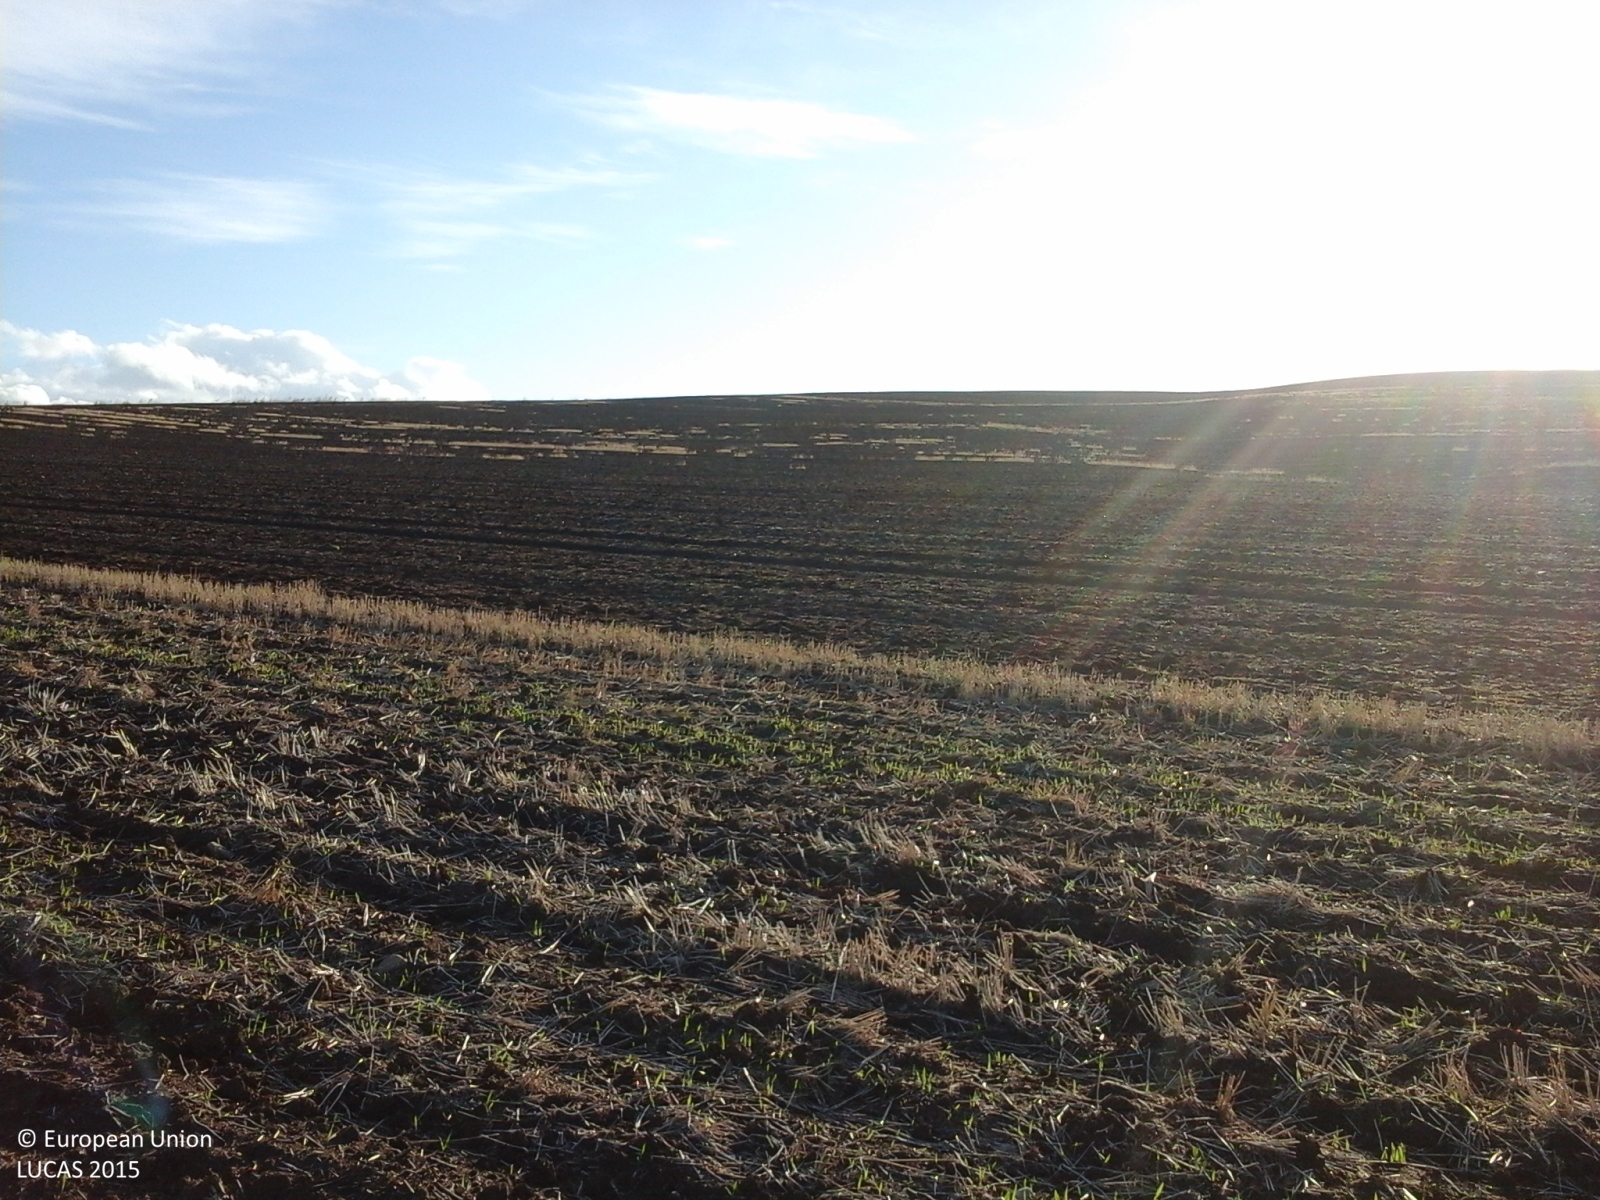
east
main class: Cropland
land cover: Durum wheat
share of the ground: > 75 %
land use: Agriculture (excluding fallow land and kitchen gardens)
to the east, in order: Durum wheat; Dry pulses
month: September
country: IT
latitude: 41.7234
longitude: 15.2125
